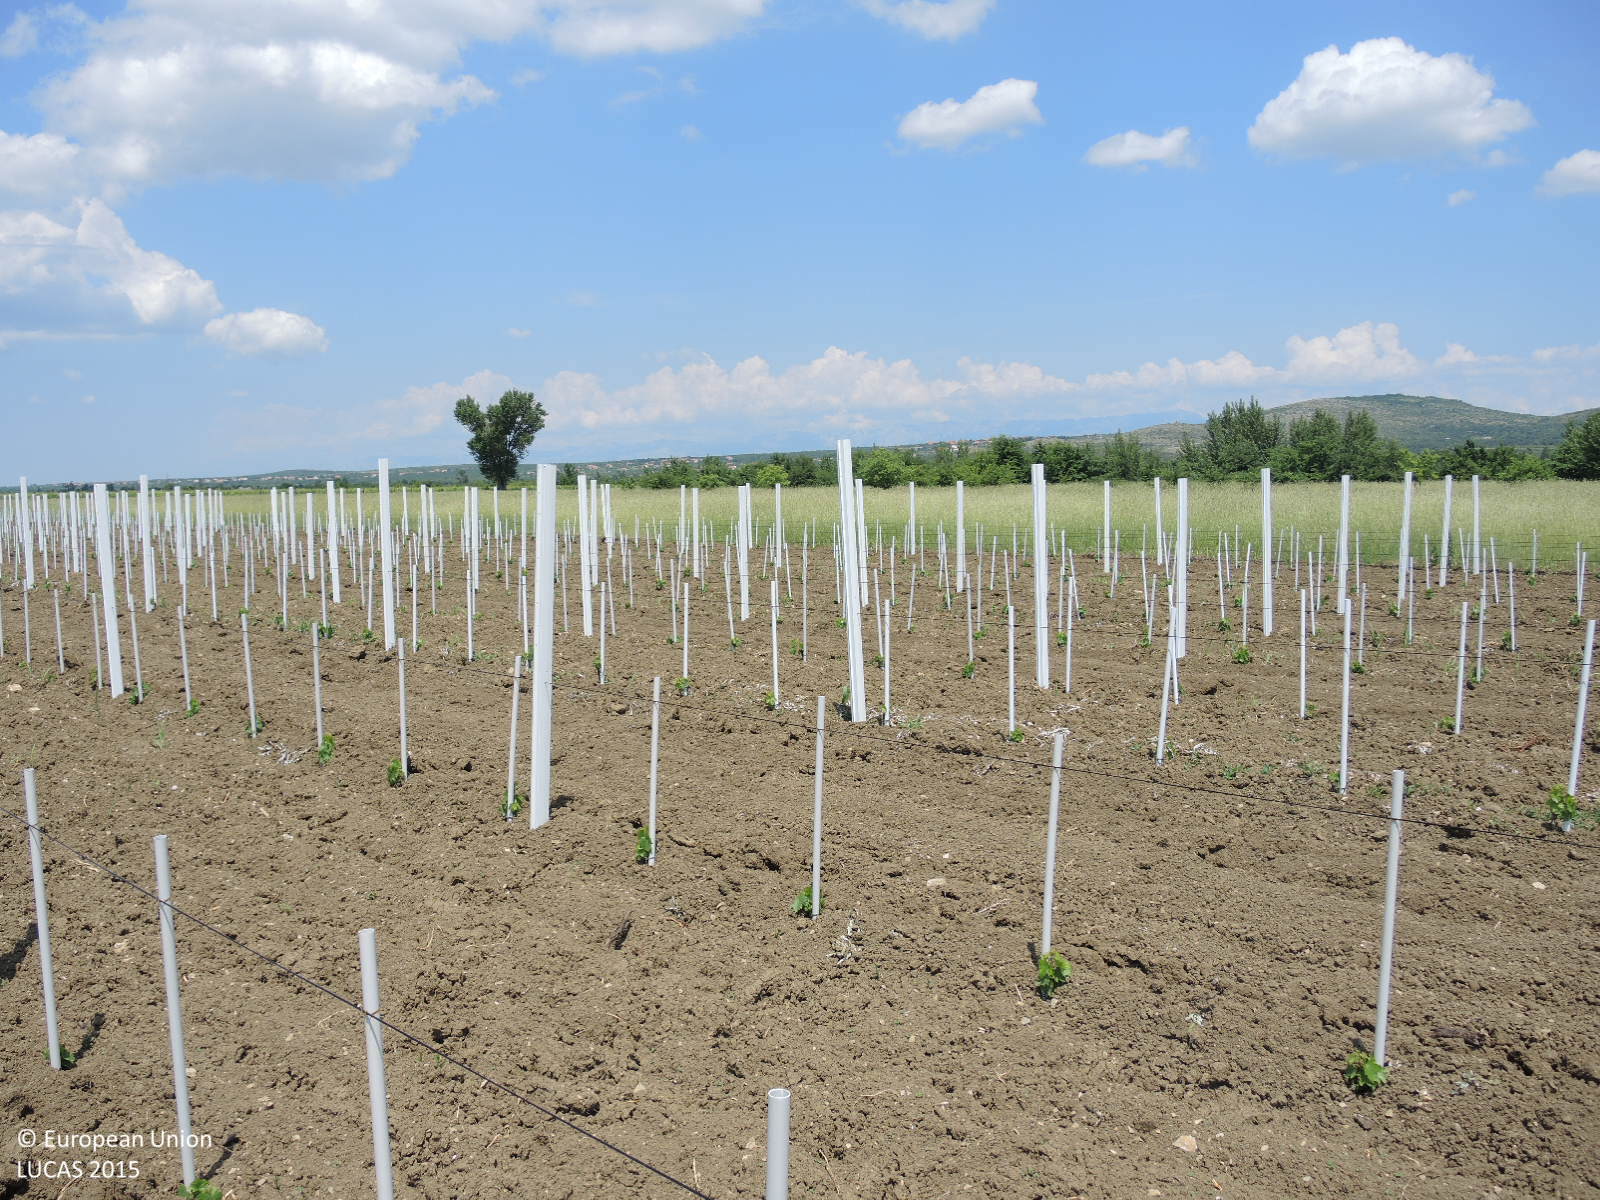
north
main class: Cropland
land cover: Vineyards
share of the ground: < 10 %
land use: Agriculture (excluding fallow land and kitchen gardens)
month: May
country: HR
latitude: 44.0423
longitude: 15.4954
